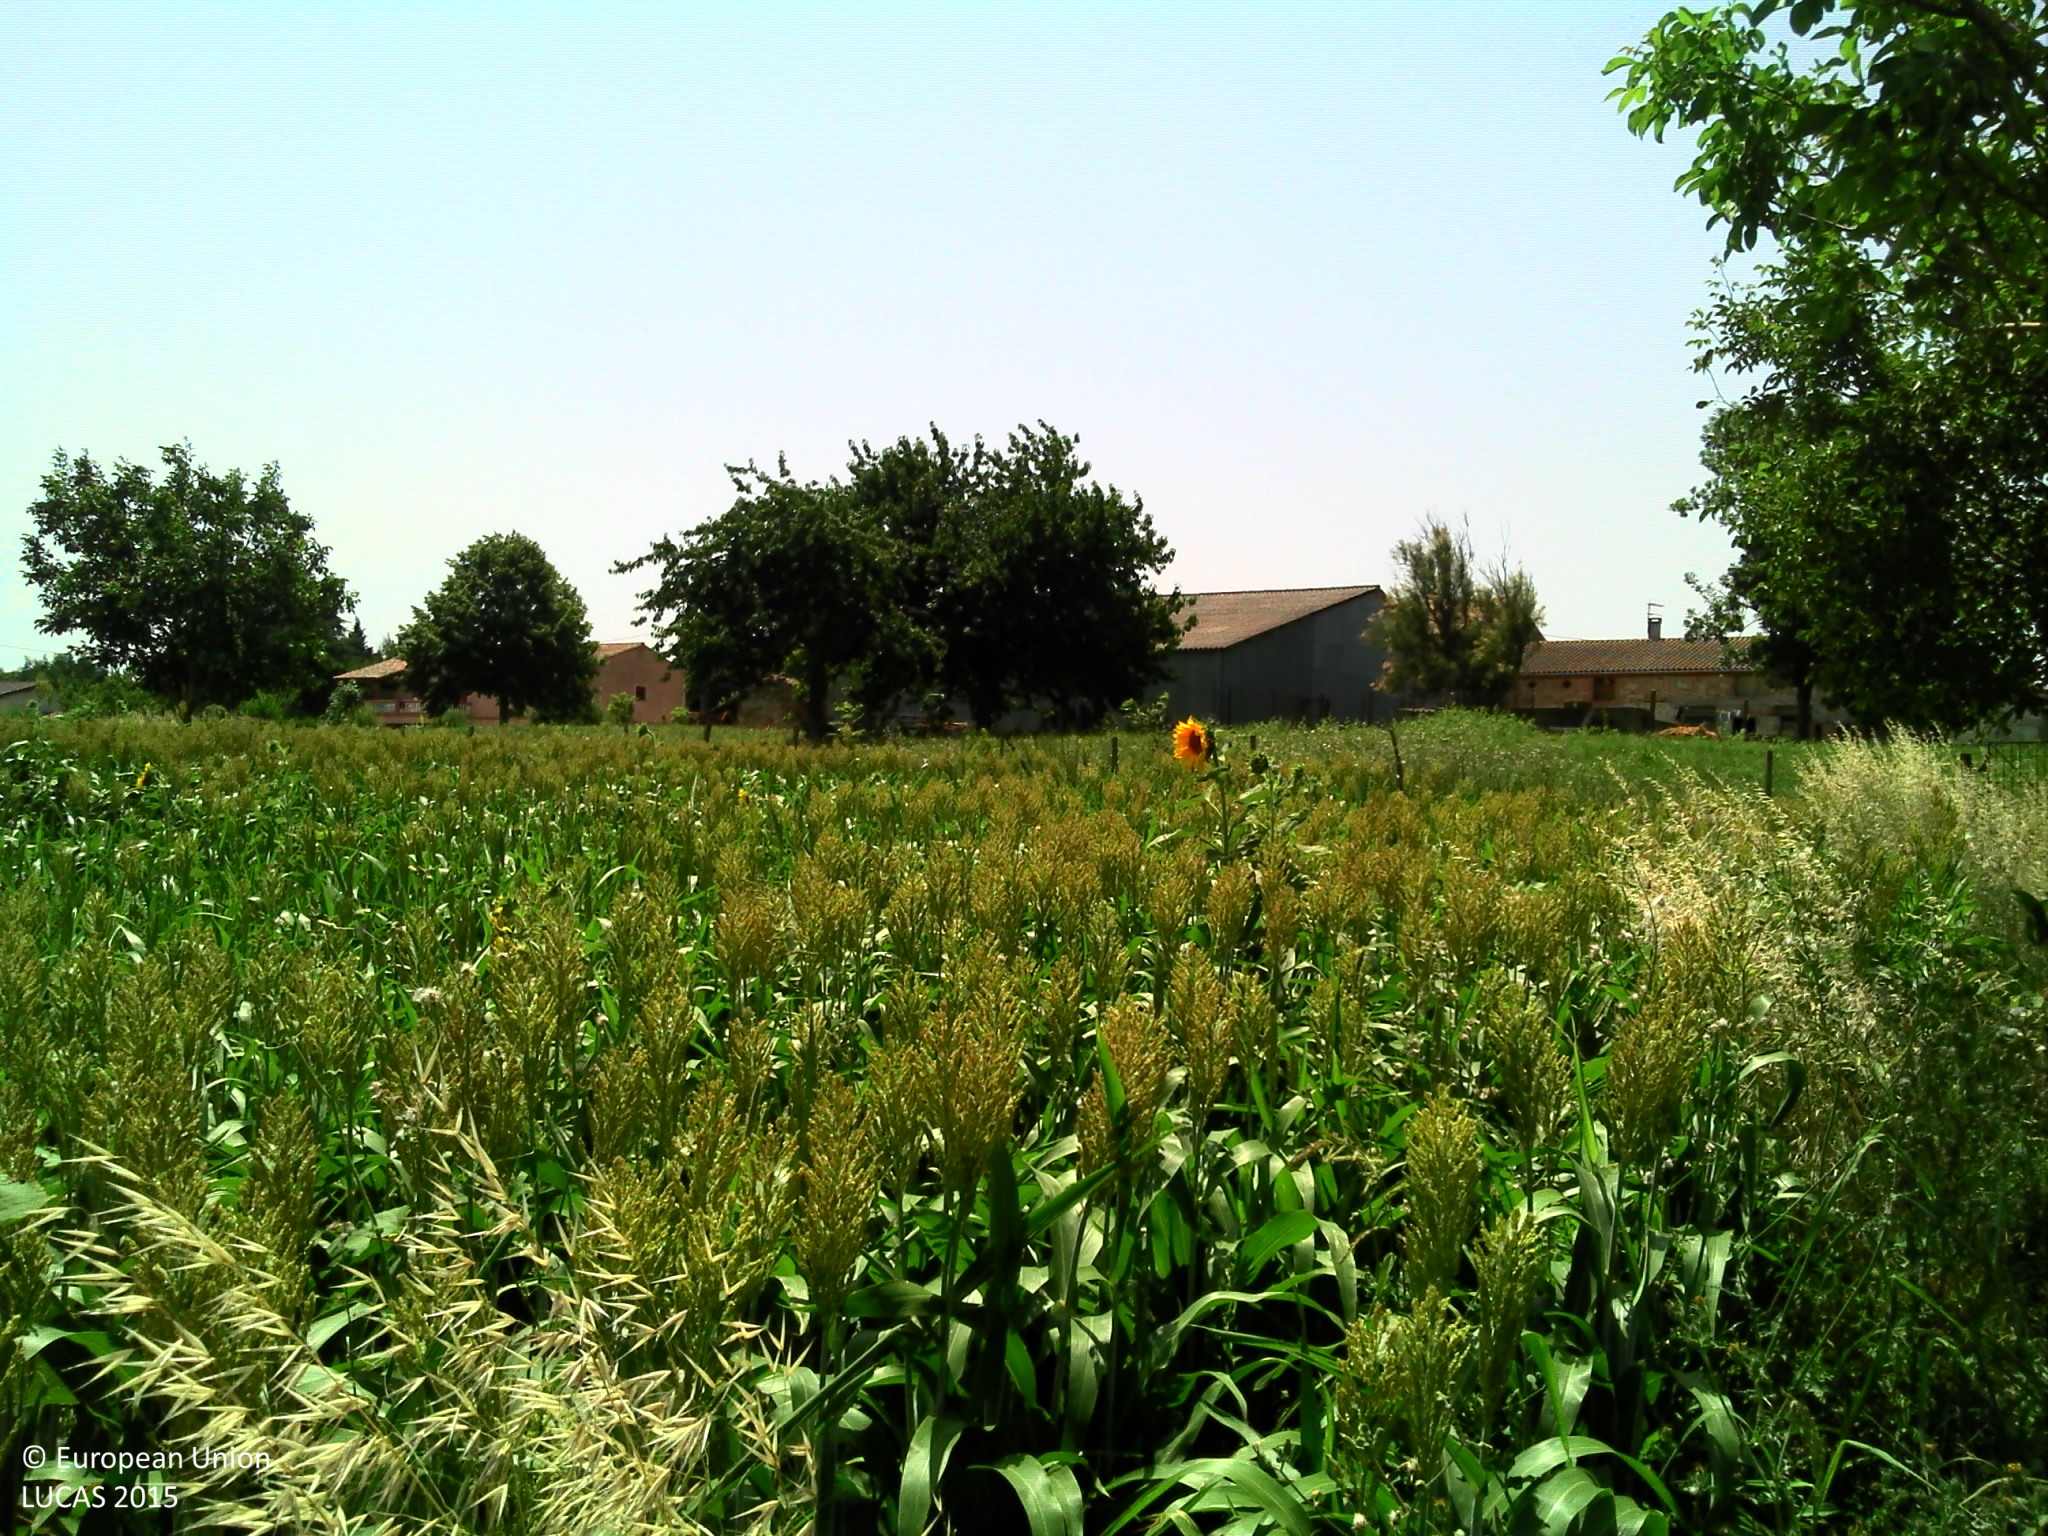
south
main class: Grassland
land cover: Grassland without tree/shrub cover
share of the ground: > 75 %
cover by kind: herbaceous plants 100 %
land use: Agriculture (excluding fallow land and kitchen gardens)
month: July
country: FR
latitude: 43.6318
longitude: 1.6370
